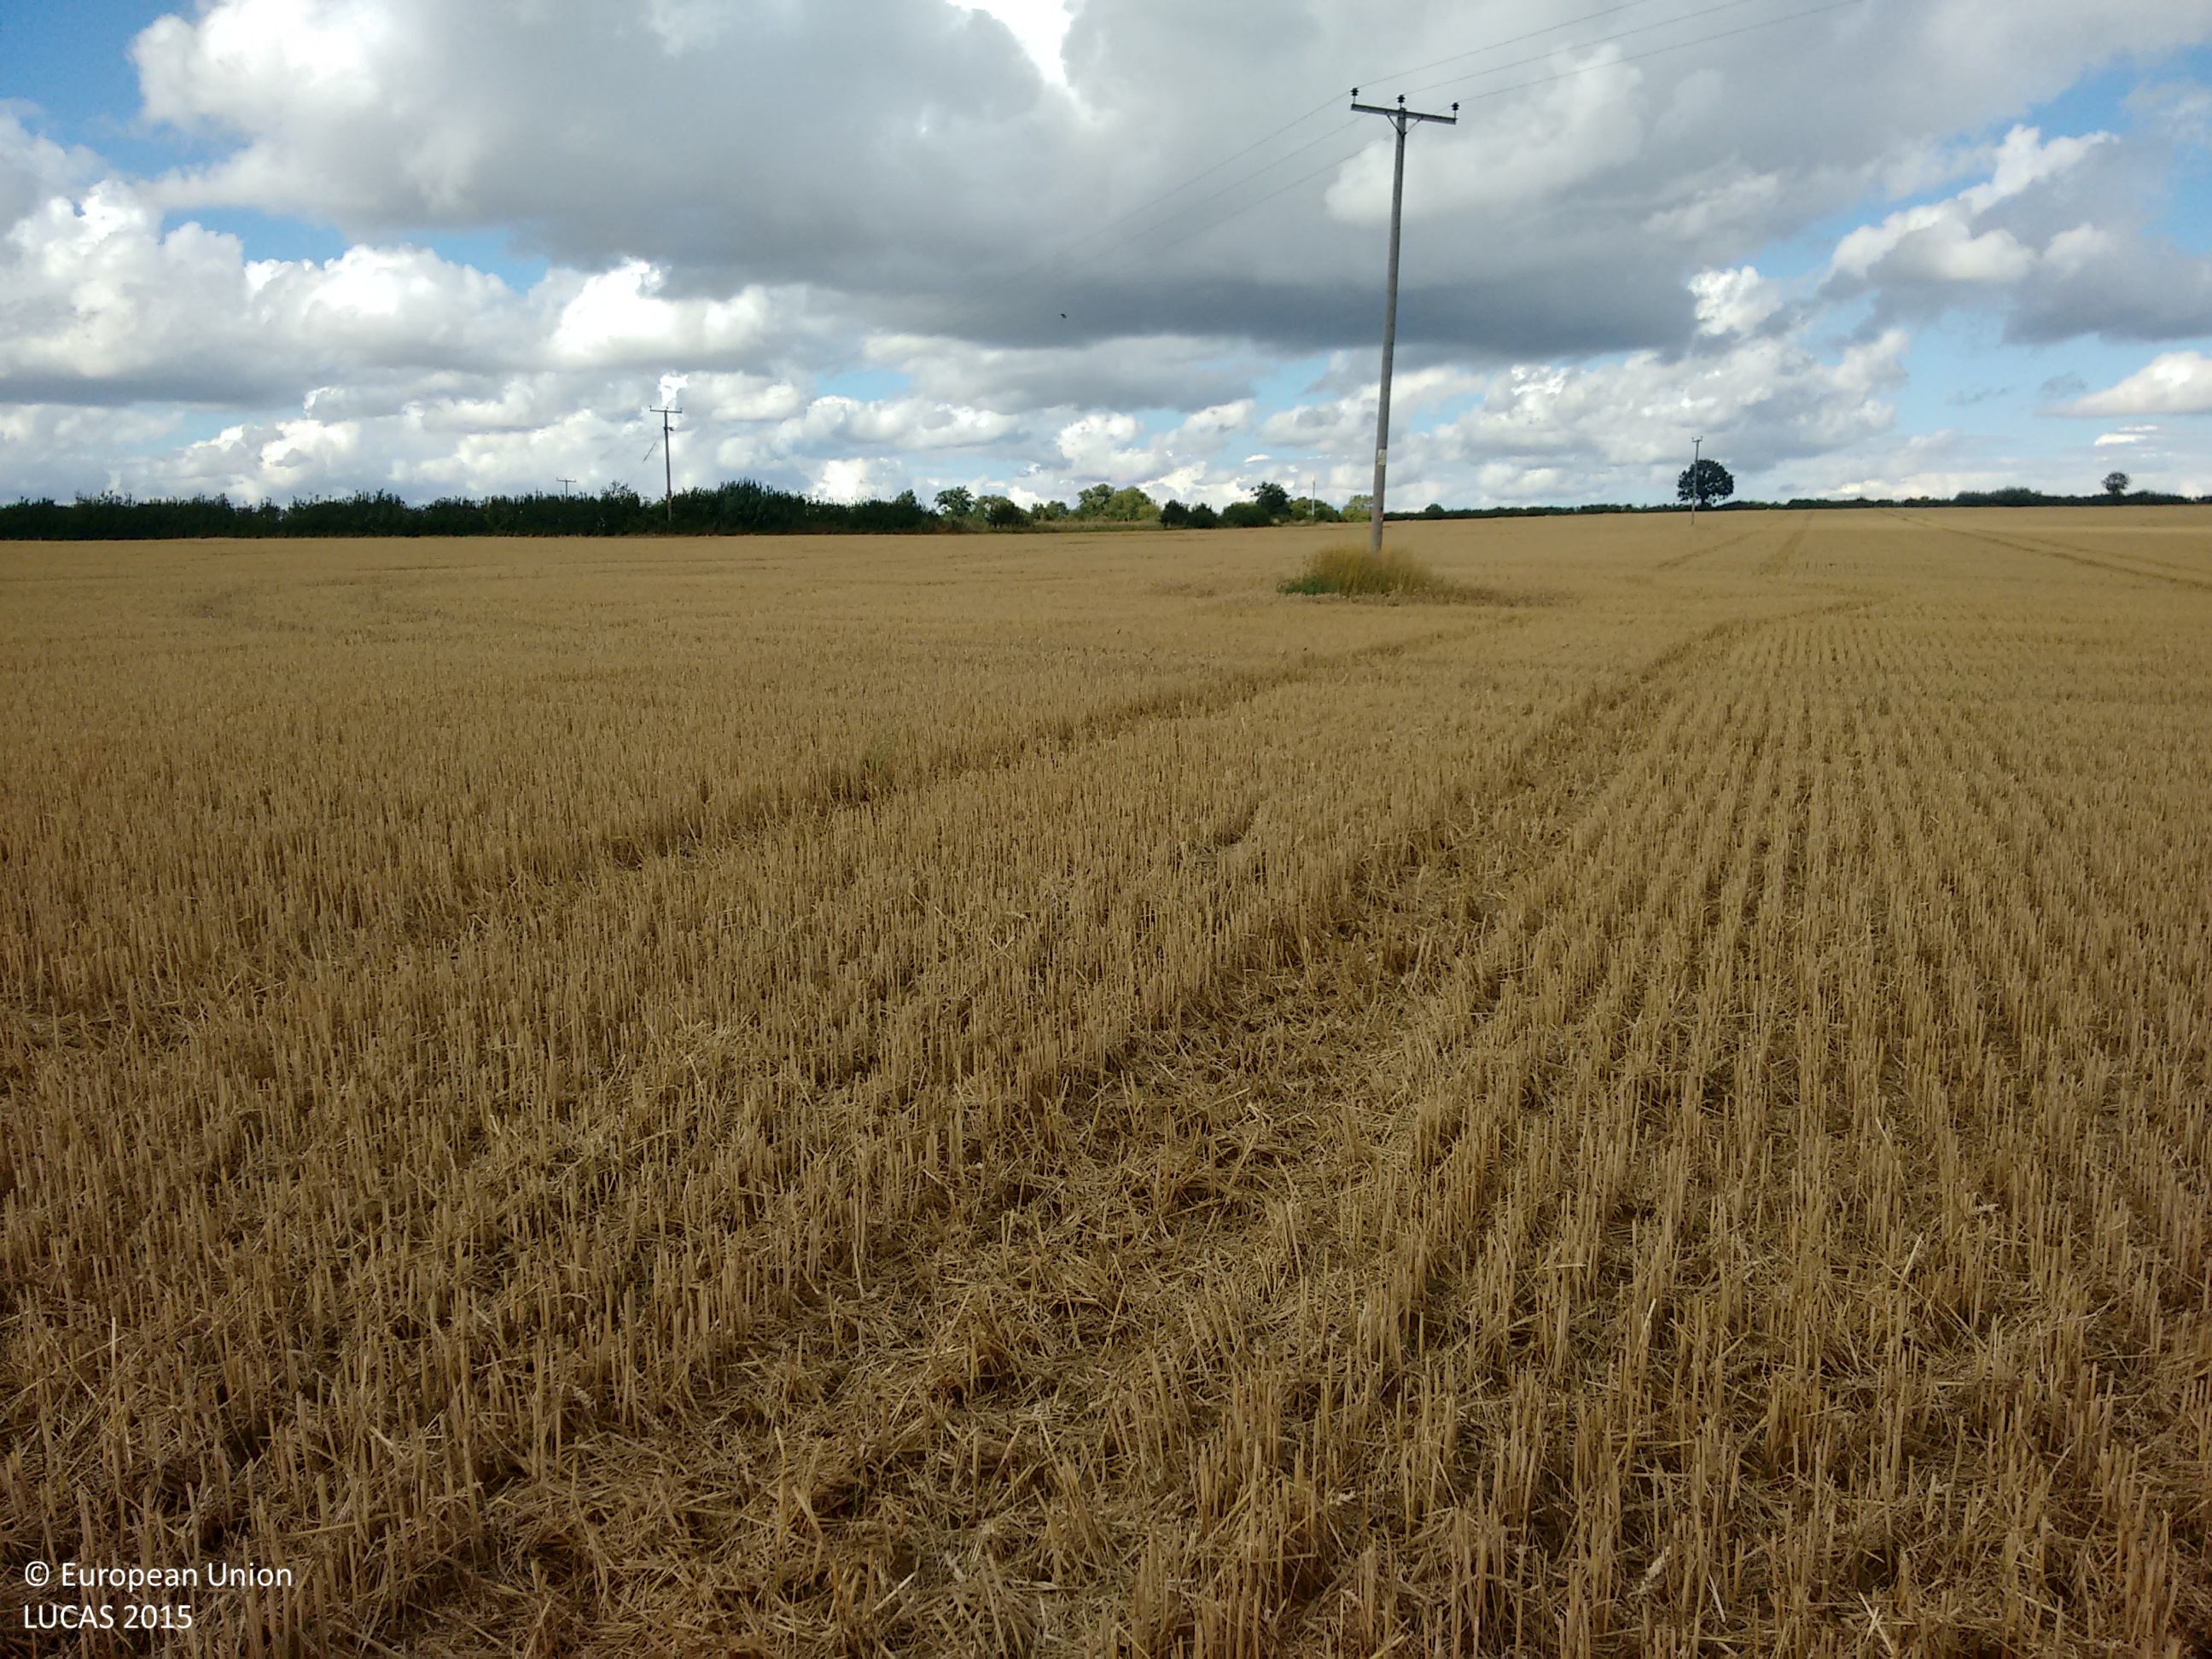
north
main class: Cropland
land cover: Common wheat
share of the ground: > 75 %
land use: Agriculture (excluding fallow land and kitchen gardens)
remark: Harvested field
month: August
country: GB
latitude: 52.1645
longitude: 0.5726
